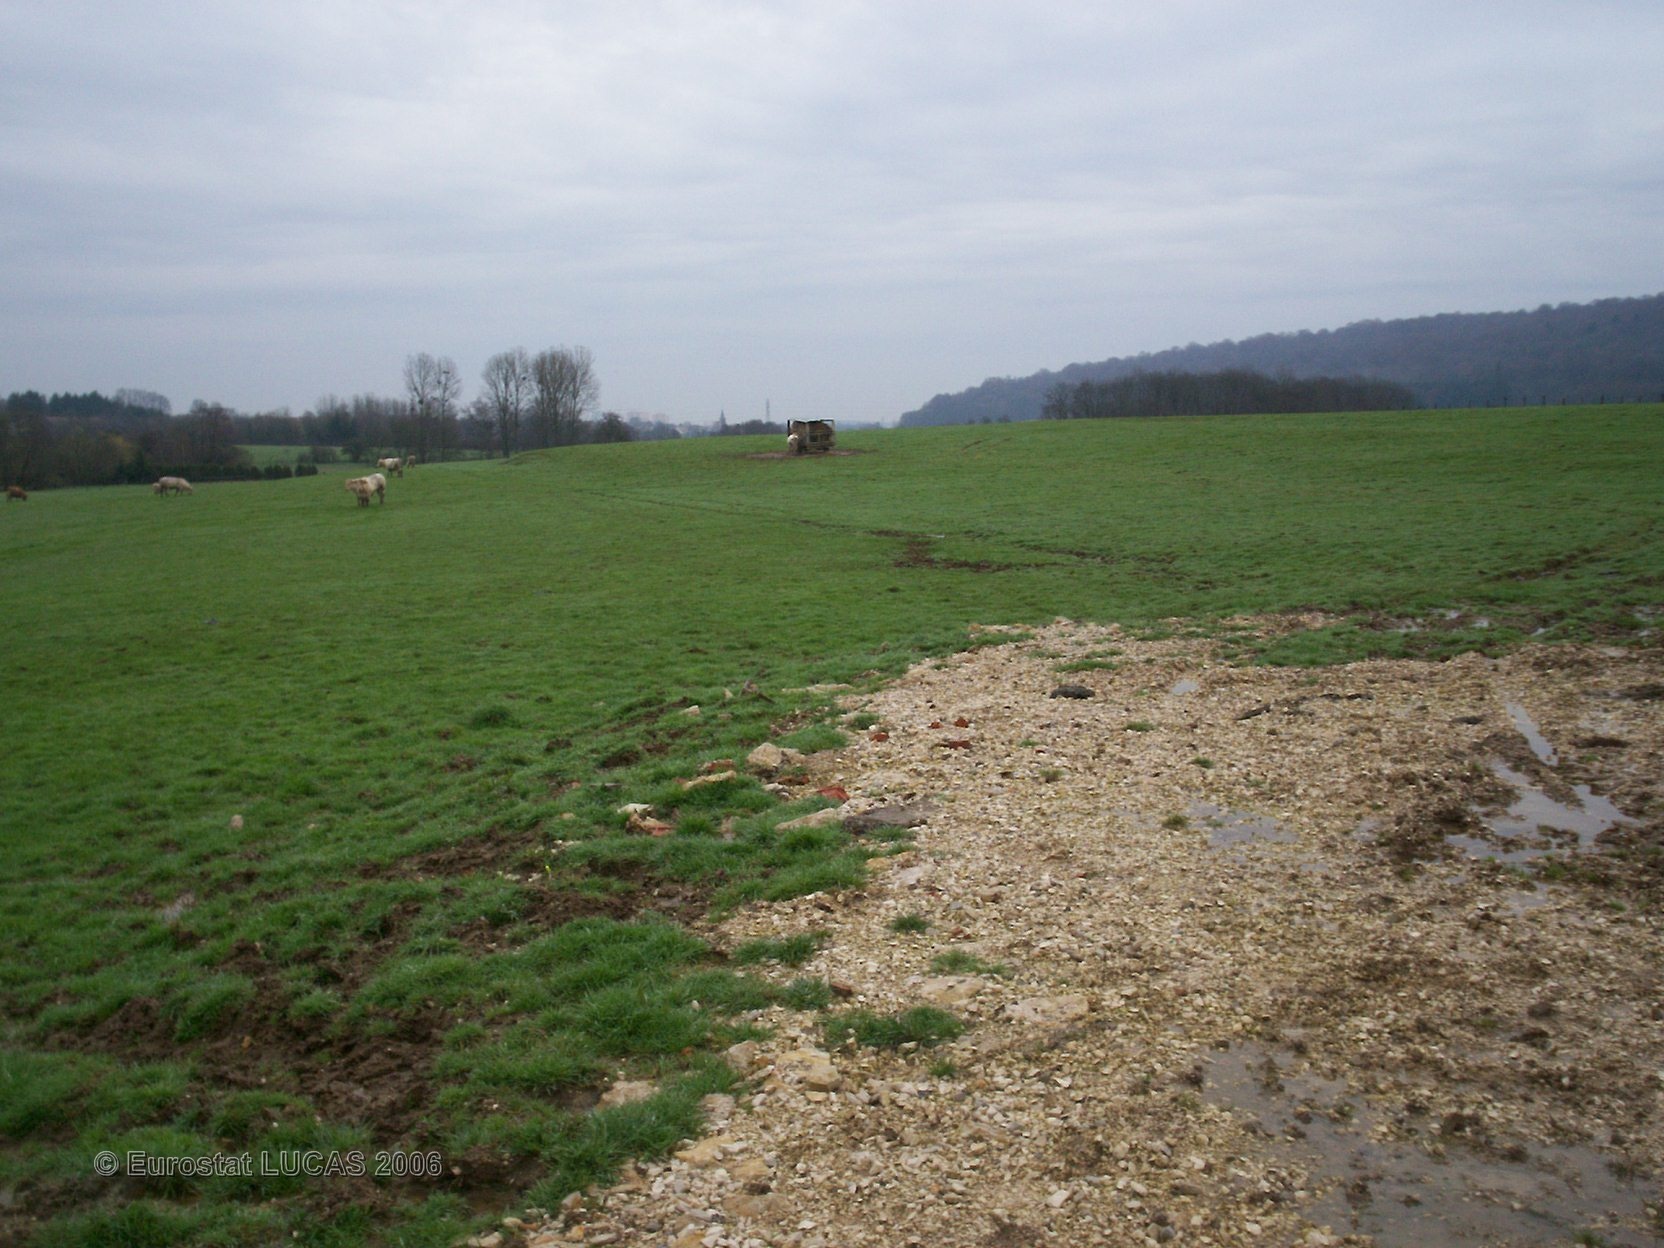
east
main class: Grassland
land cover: Grassland without tree/shrub cover
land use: Agriculture (excluding fallow land and kitchen gardens)
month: April
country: FR
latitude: 47.6366
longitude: 6.7939
